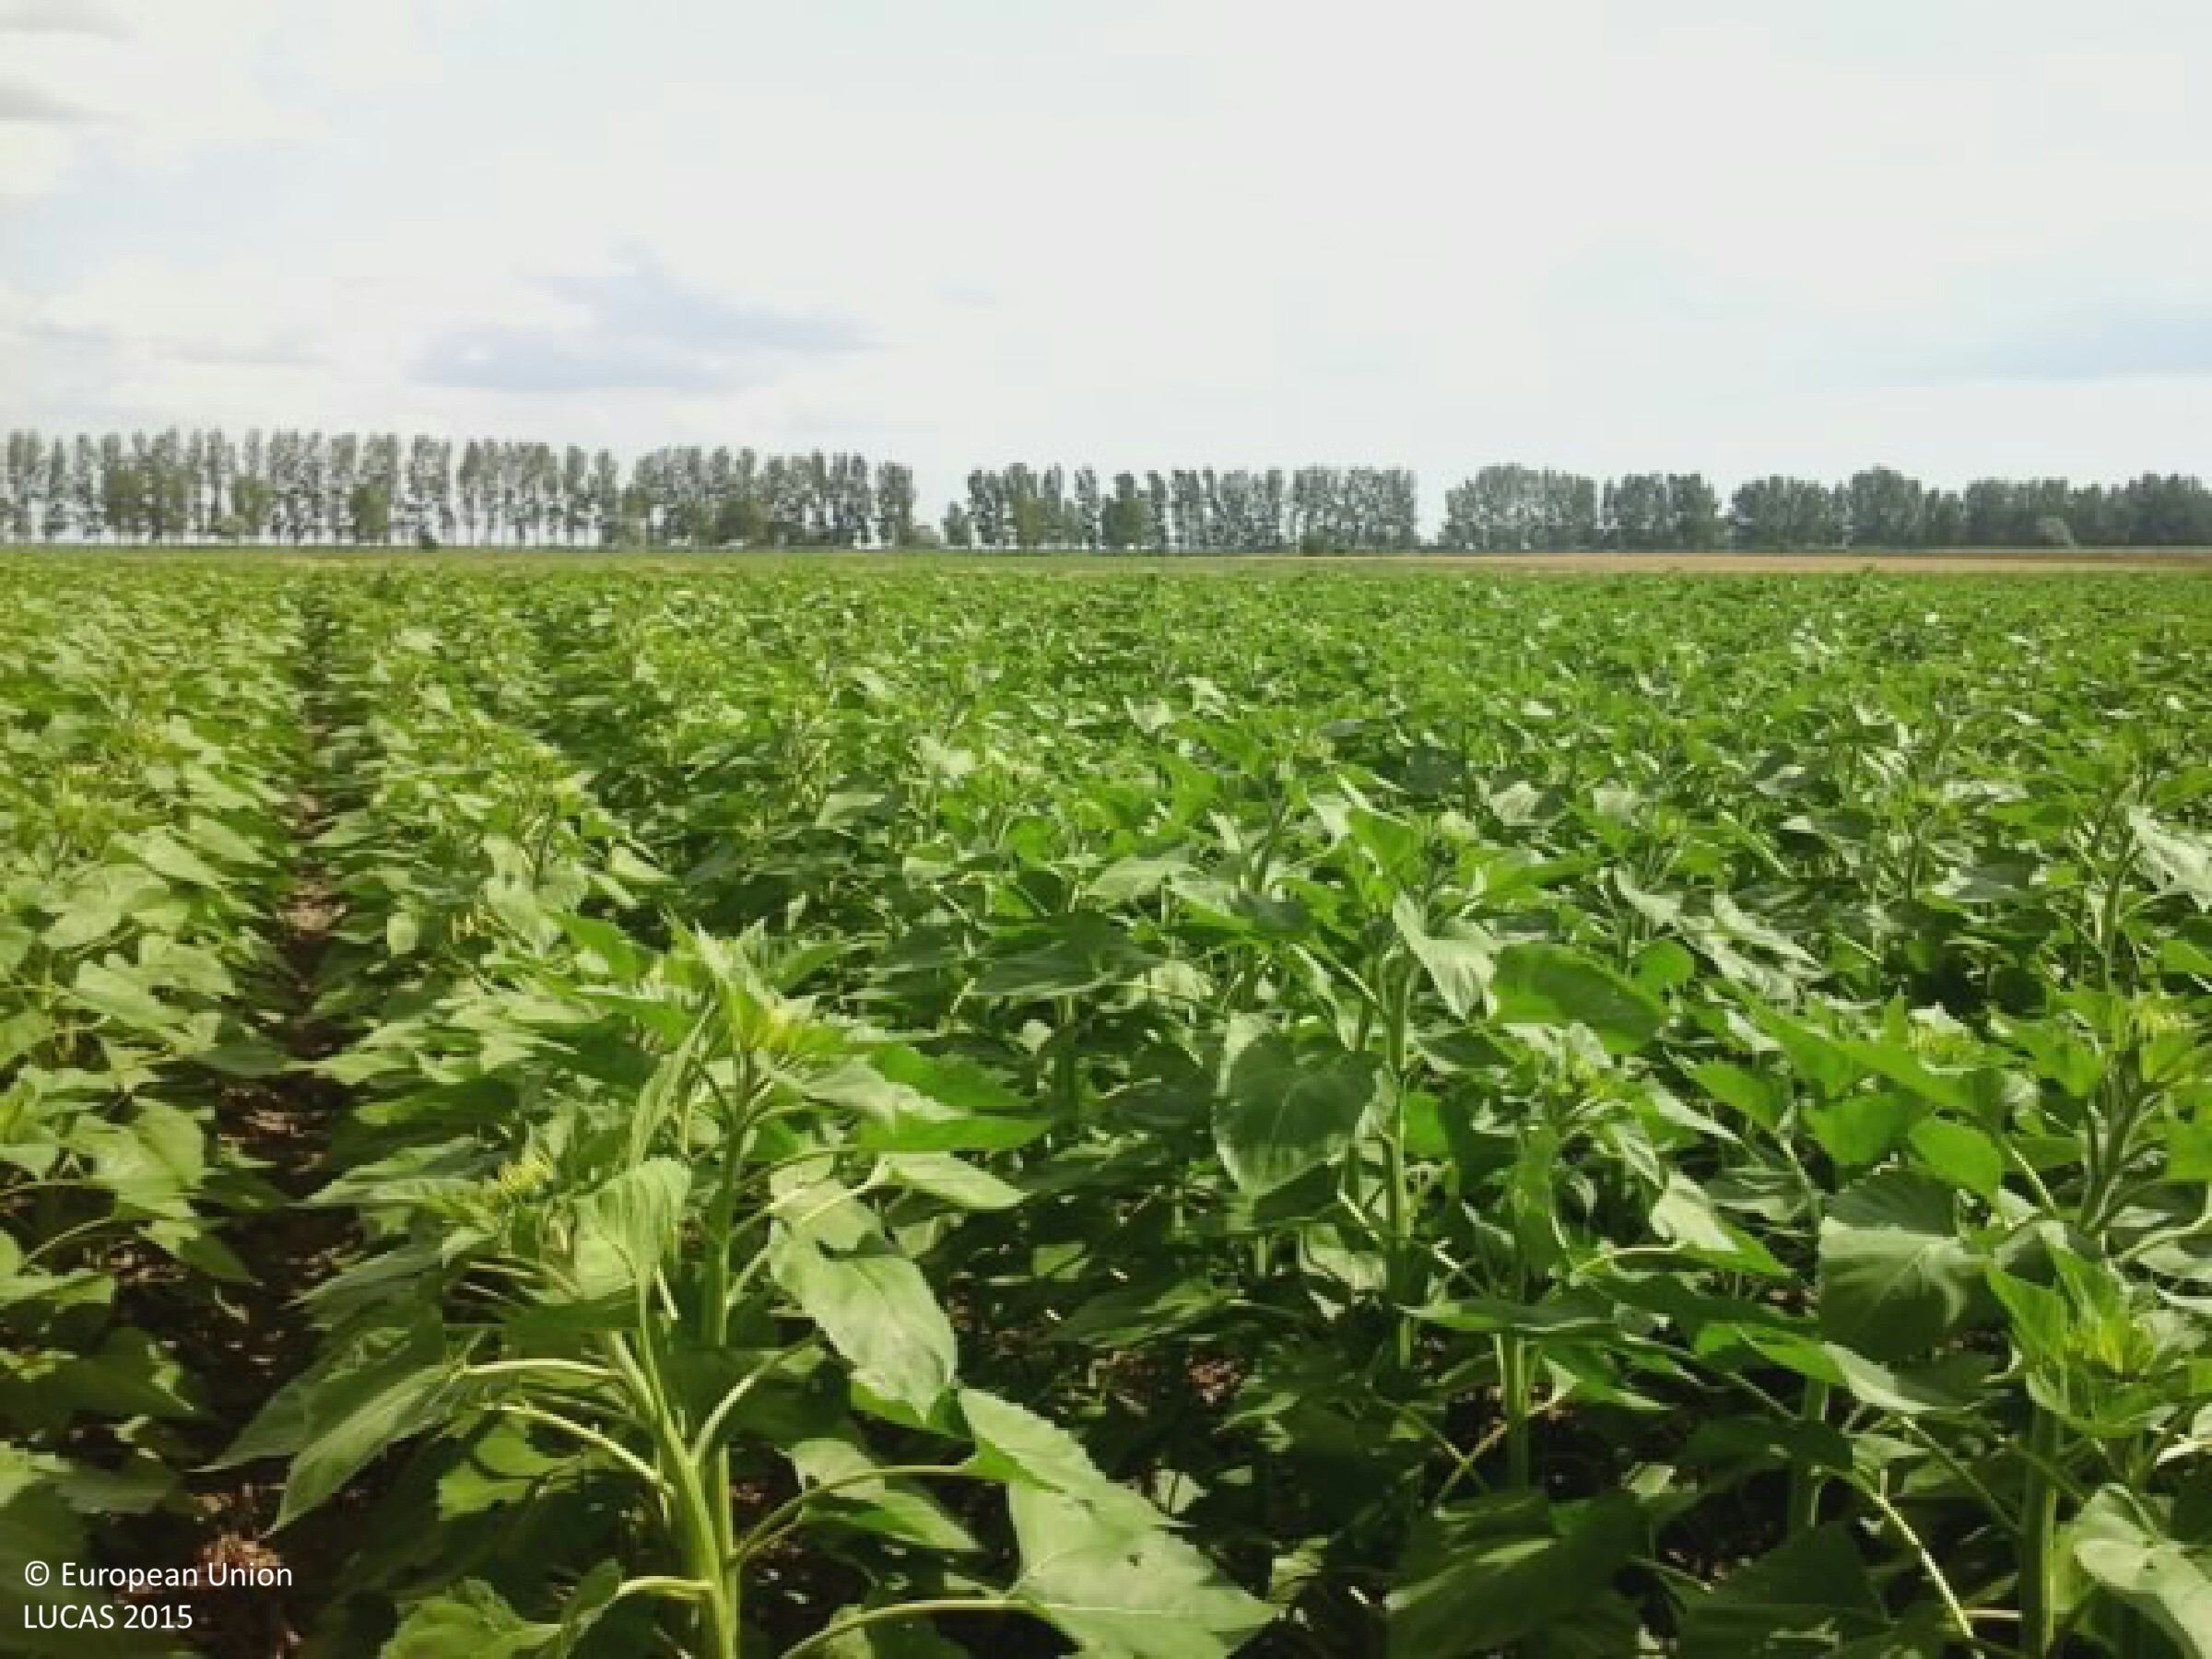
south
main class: Cropland
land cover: Sunflower
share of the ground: > 75 %
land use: Agriculture (excluding fallow land and kitchen gardens)
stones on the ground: < 10 %
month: July
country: HU
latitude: 47.1445
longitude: 19.0494
